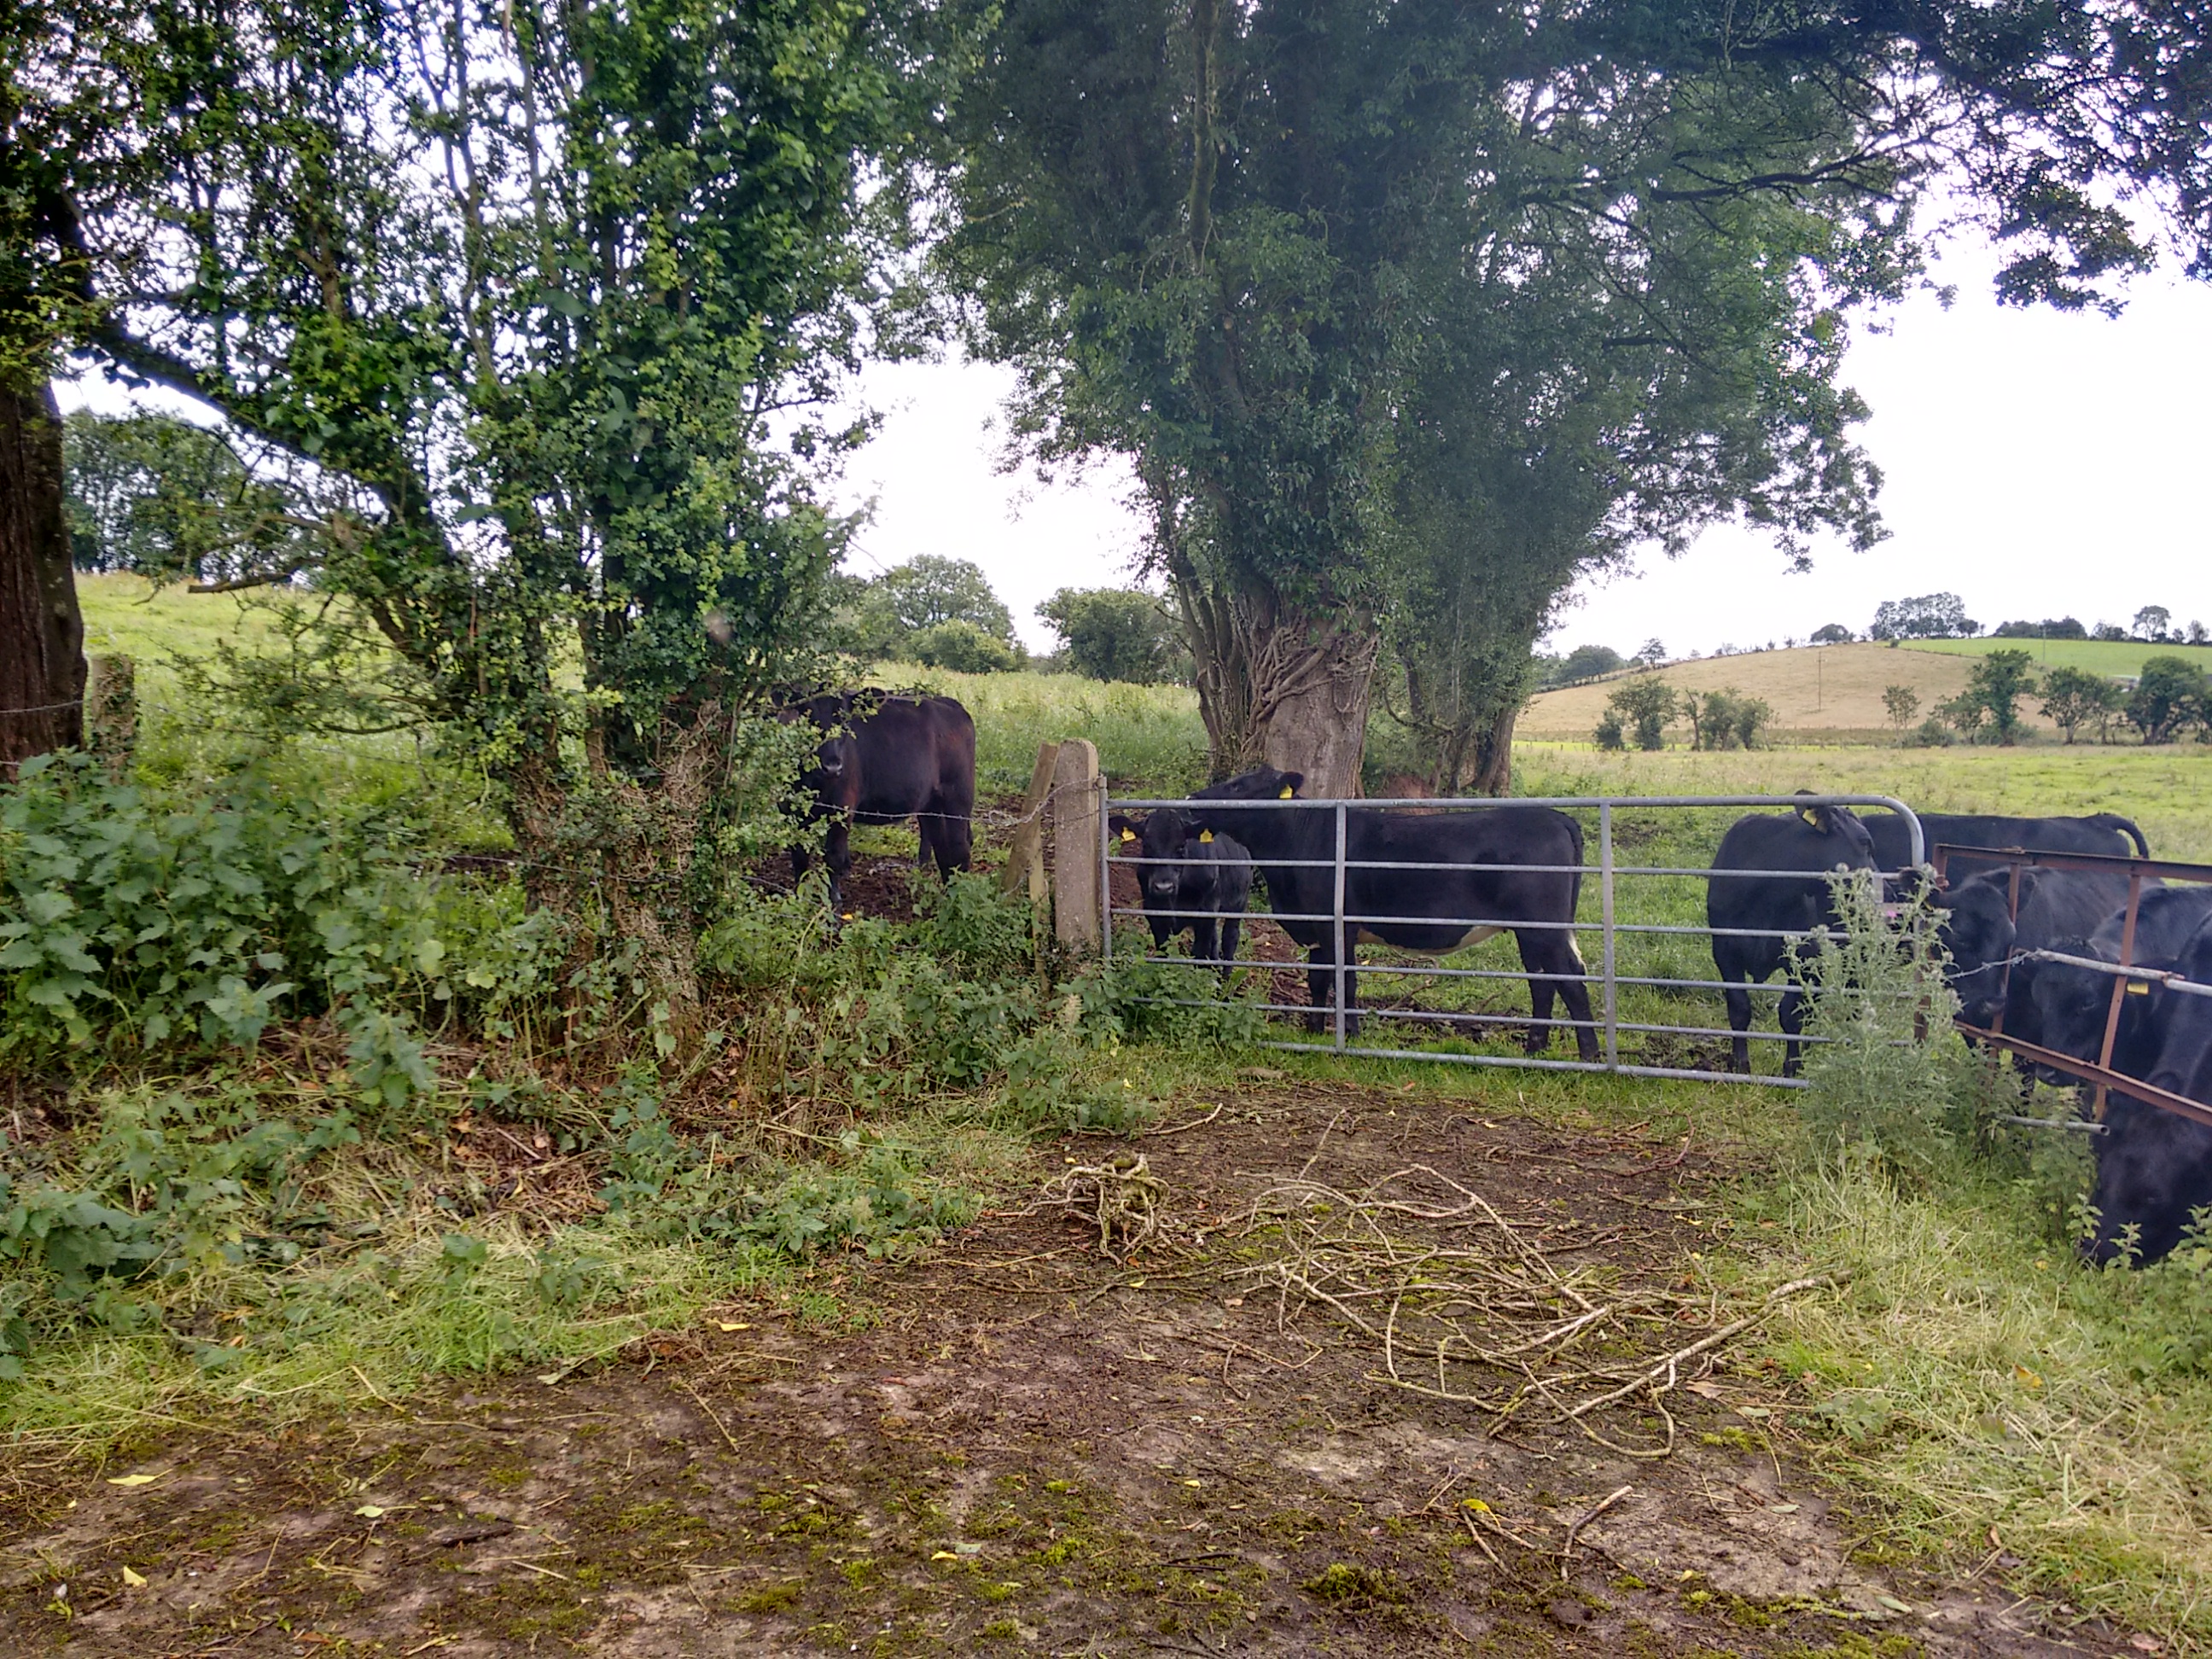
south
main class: Grassland
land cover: Grassland without tree/shrub cover
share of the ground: > 75 %
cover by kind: herbaceous plants 100 %
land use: Agriculture (excluding fallow land and kitchen gardens)
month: July
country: GB
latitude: 54.4005
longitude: -7.3576
